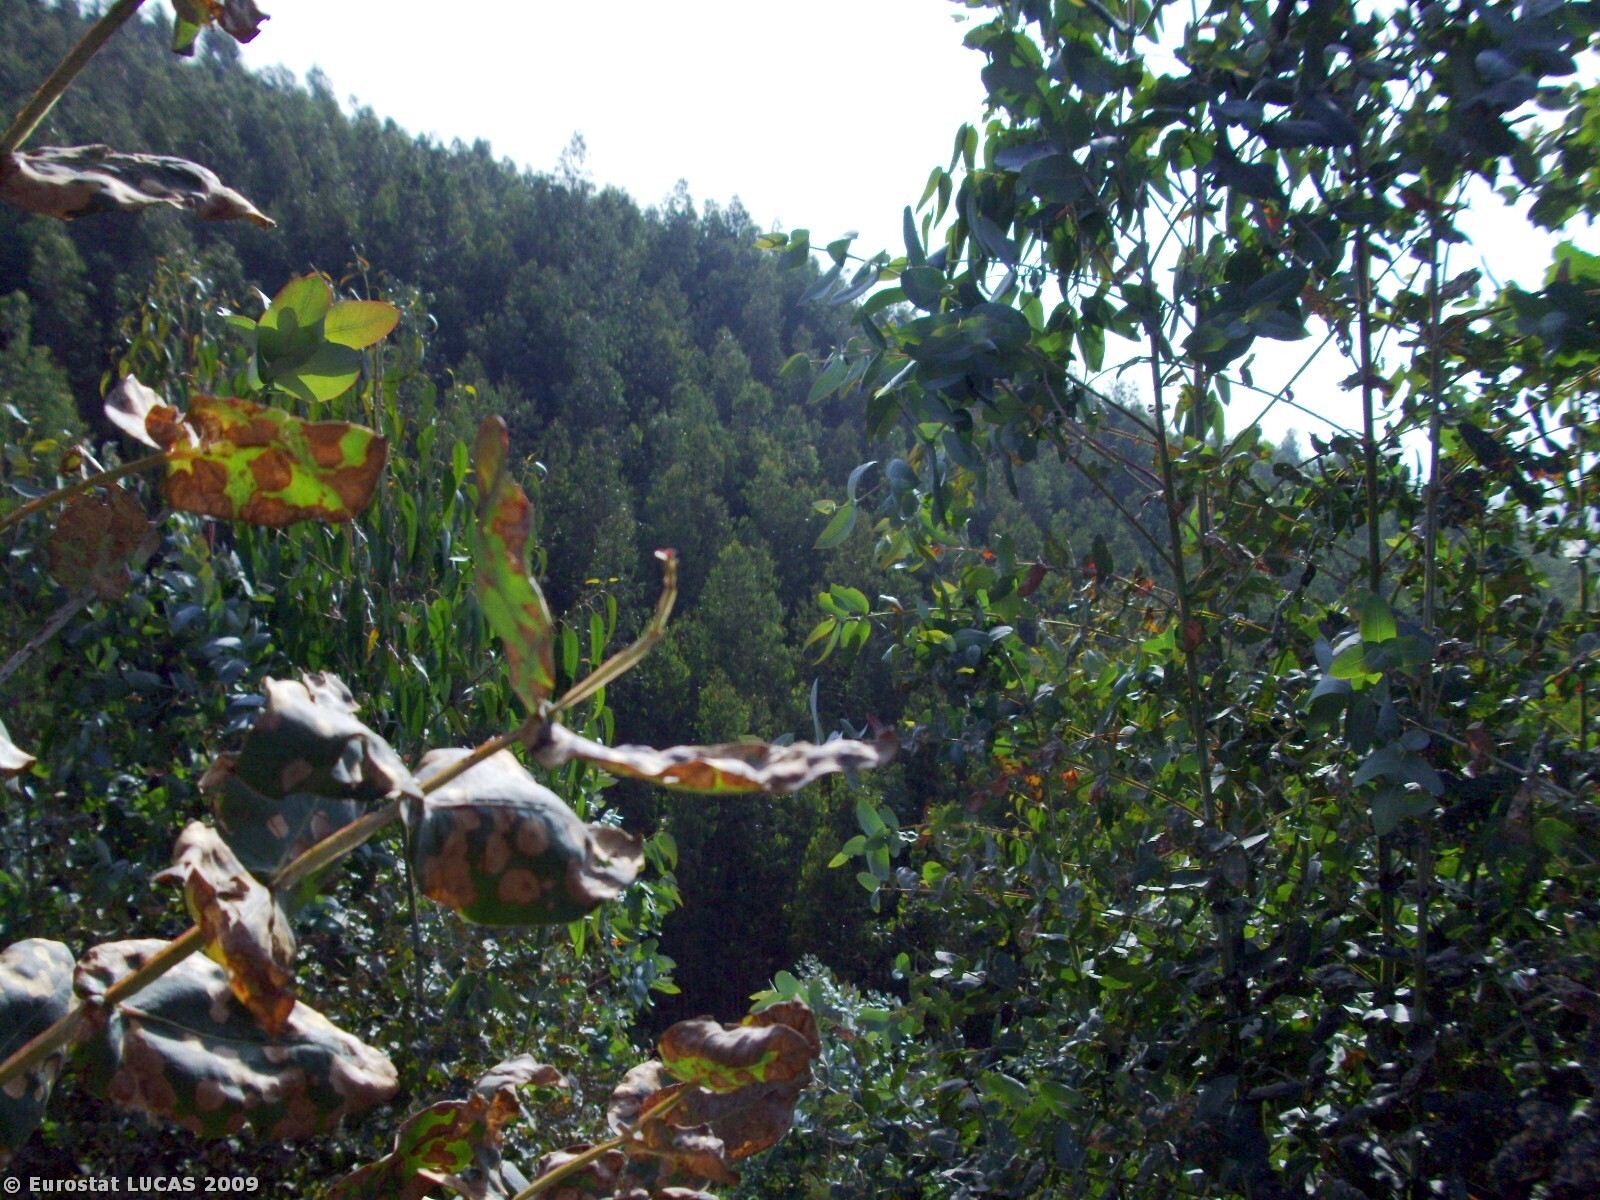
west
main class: Woodland
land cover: Broadleaved woodland
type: plantations and self-sown exotic forest
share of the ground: > 75 %
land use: Forestry
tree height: > 5 m
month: May
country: PT
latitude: 40.4609
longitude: -8.3531
